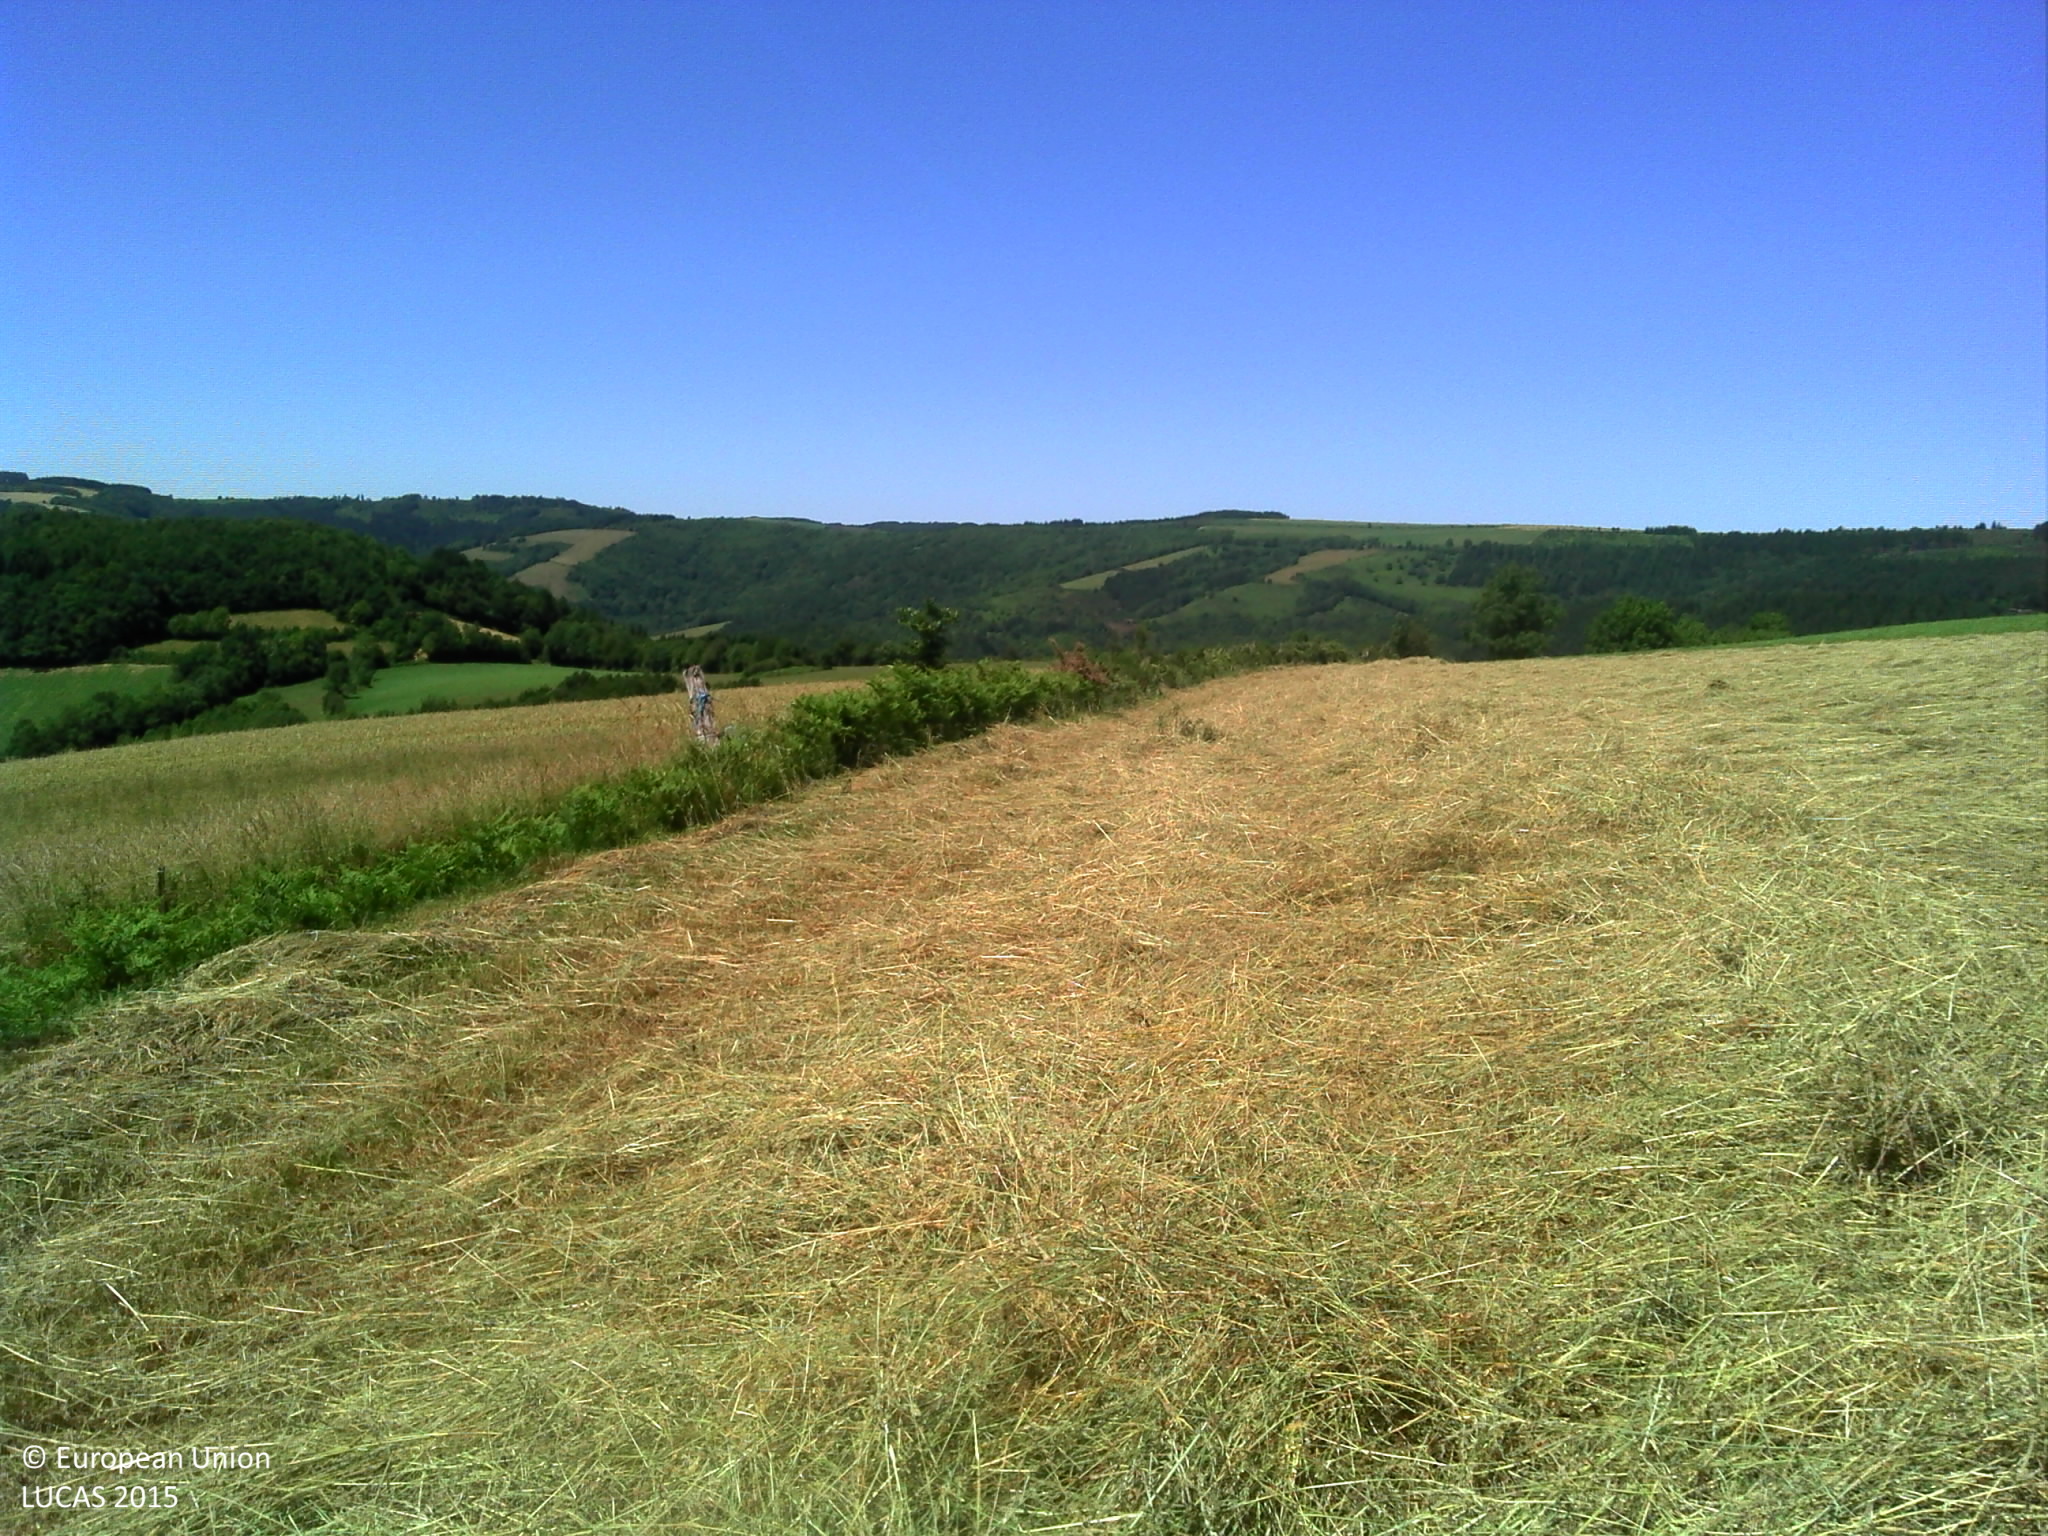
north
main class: Grassland
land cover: Grassland without tree/shrub cover
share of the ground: > 75 %
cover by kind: herbaceous plants 100 %
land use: Agriculture (excluding fallow land and kitchen gardens)
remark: Harvested field
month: June
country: FR
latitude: 43.7451
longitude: 2.6425
